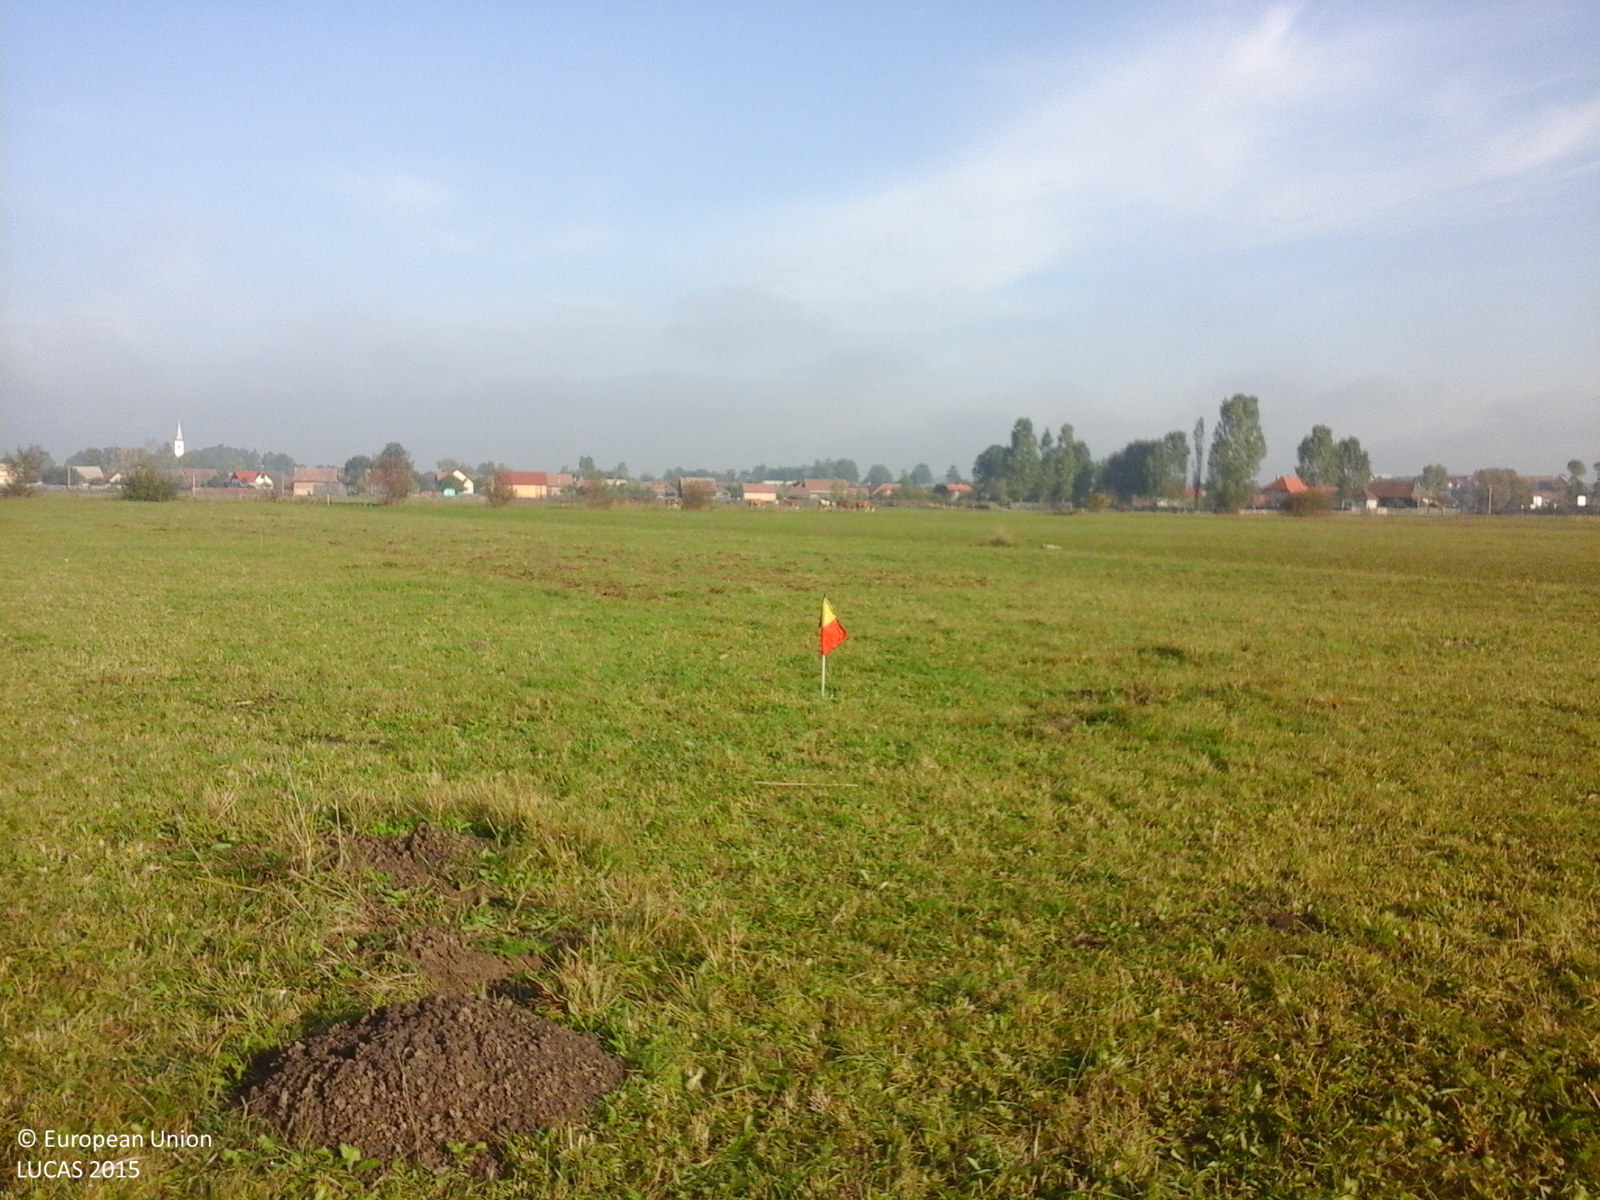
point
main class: Grassland
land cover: Grassland without tree/shrub cover
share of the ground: > 75 %
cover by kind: herbaceous plants 100 %
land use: Agriculture (excluding fallow land and kitchen gardens)
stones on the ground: < 10 %
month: October
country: RO
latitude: 46.2348
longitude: 25.8977
